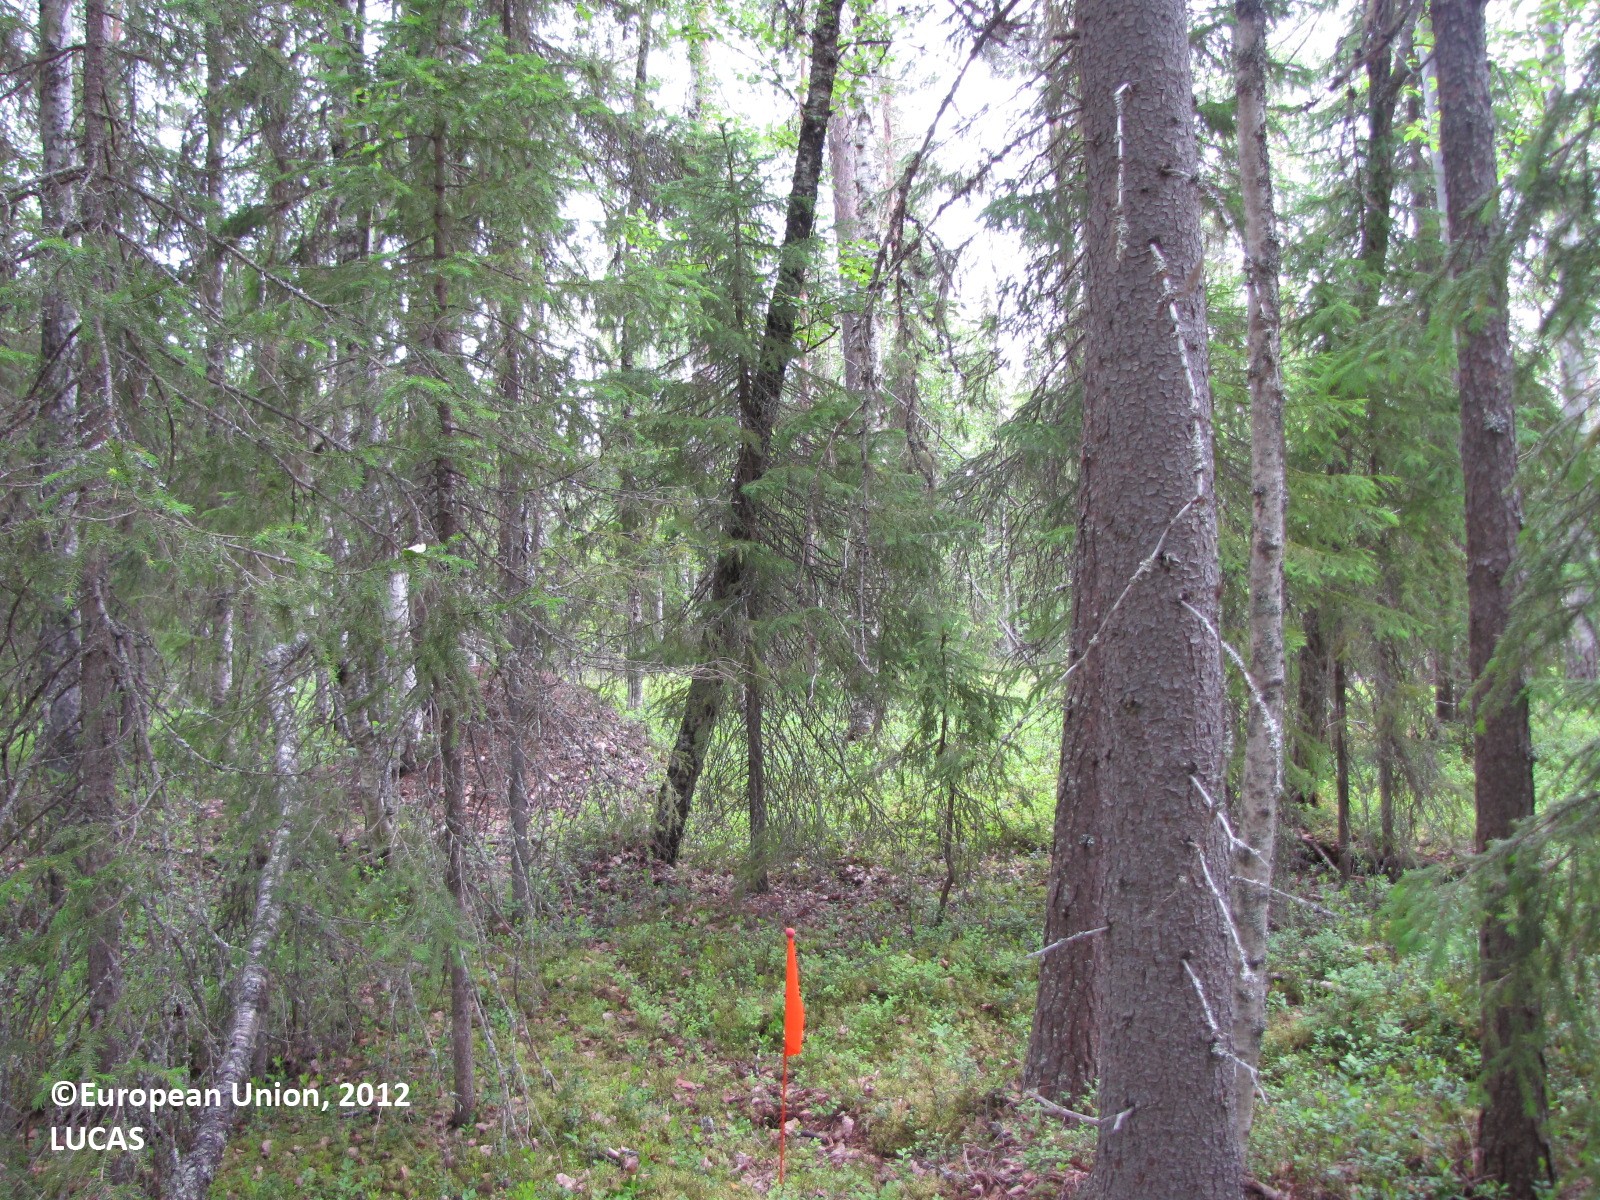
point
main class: Woodland
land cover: Spruce dominated mixed woodland
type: boreal forest
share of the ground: 50 - 75 %
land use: Forestry
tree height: > 5 m
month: July
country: FI
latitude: 66.6380
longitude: 24.9897
